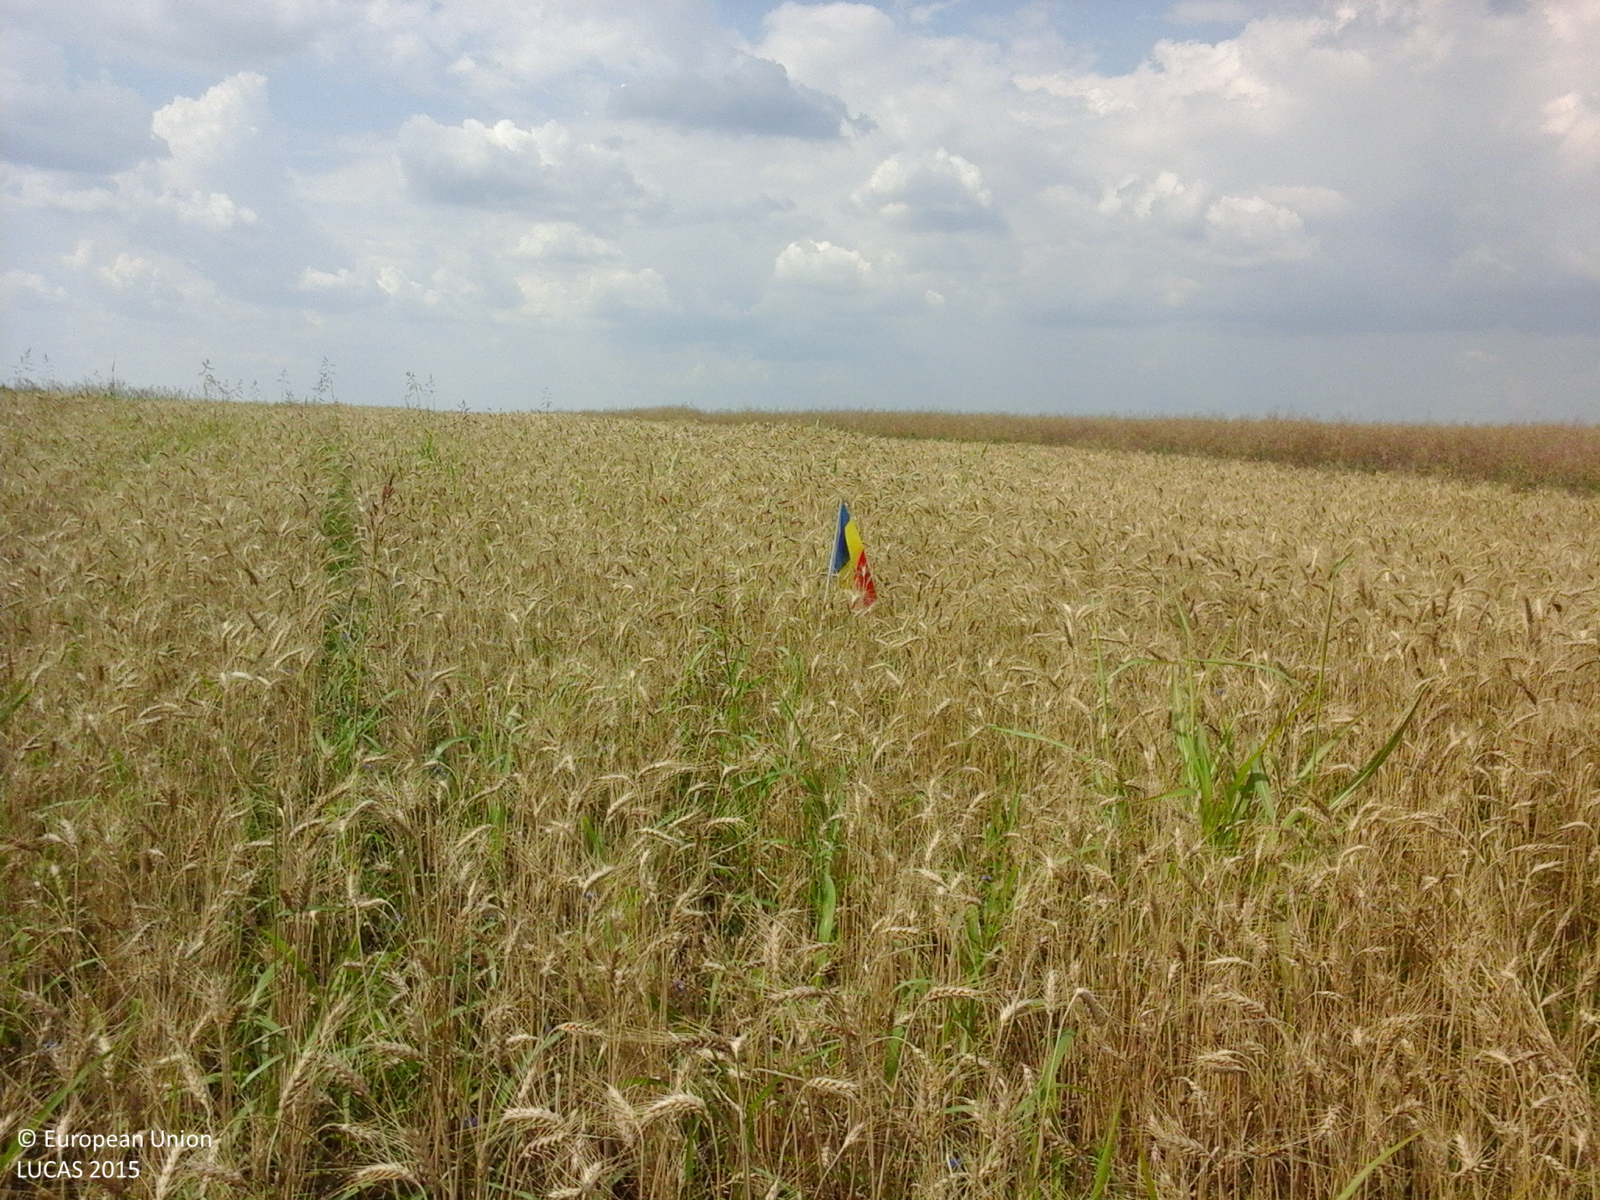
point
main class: Cropland
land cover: Common wheat
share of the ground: > 75 %
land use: Agriculture (excluding fallow land and kitchen gardens)
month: July
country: RO
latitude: 44.0199
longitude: 25.2641
